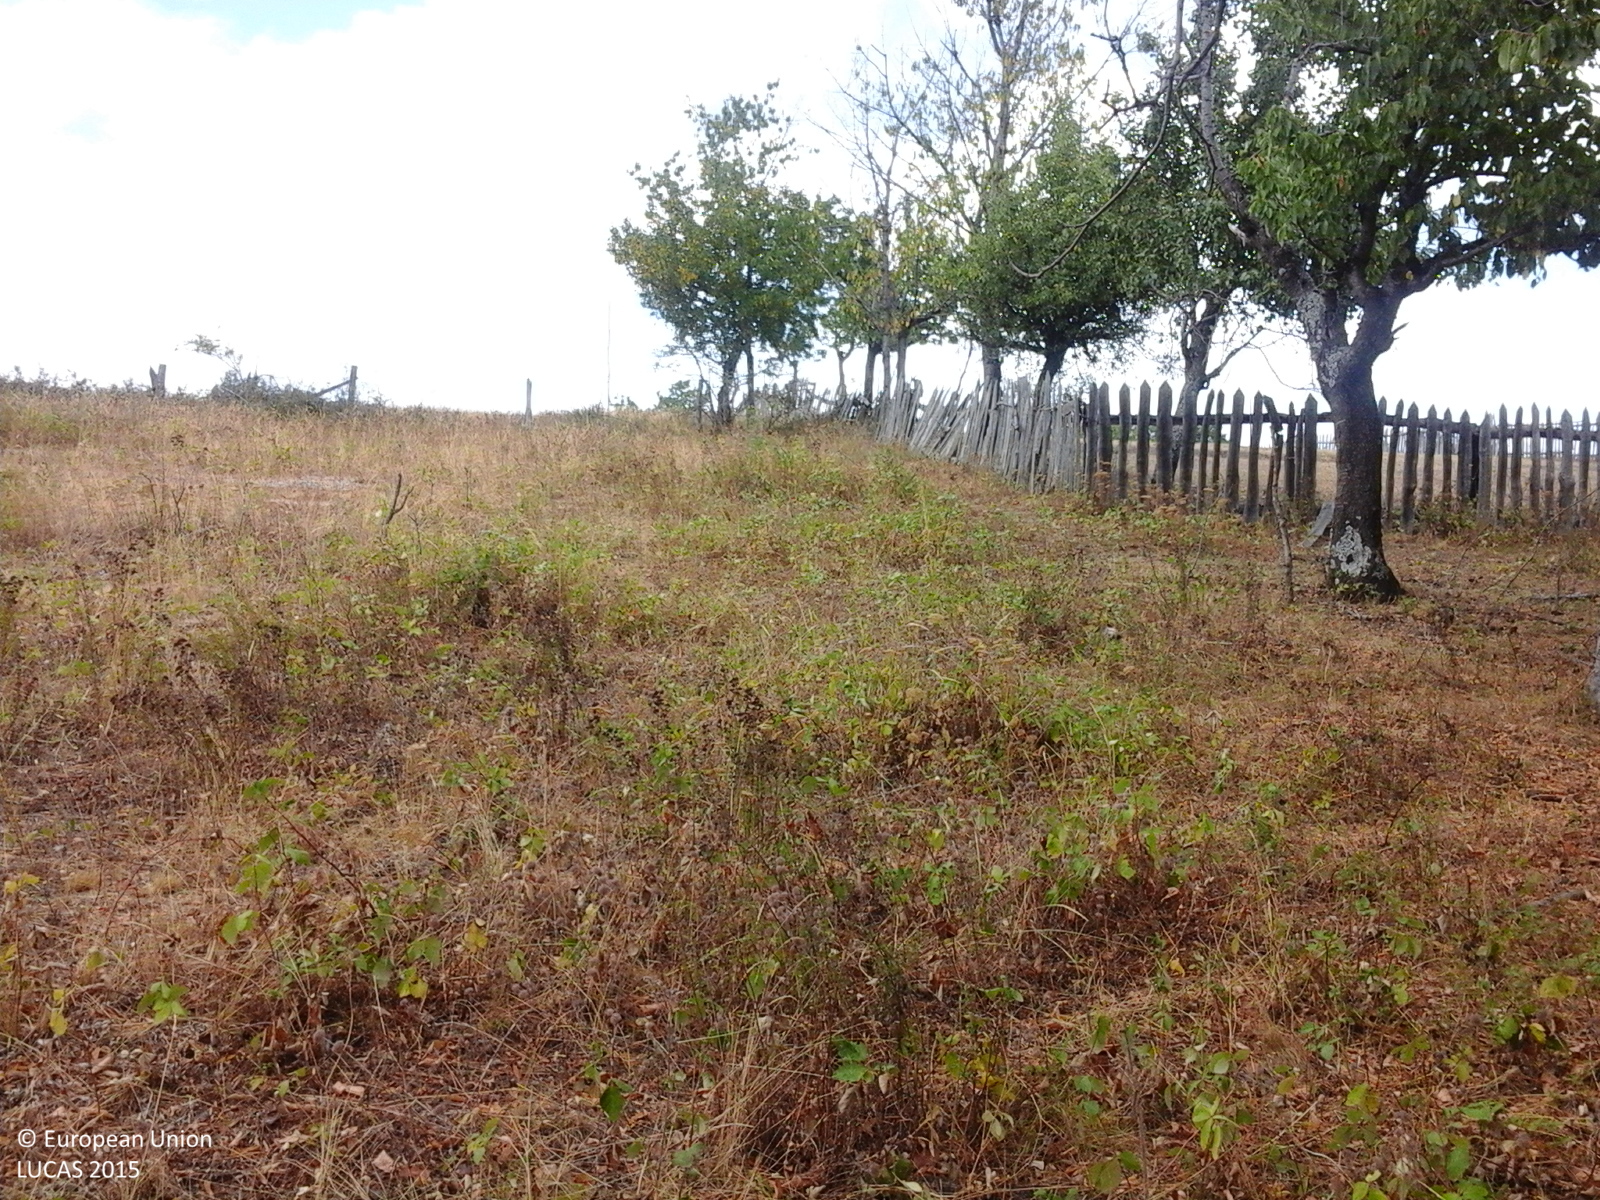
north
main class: Woodland
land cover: Broadleaved woodland
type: acidophilous oak and oak-birch forest
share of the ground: > 75 %
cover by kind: broadleaved forest trees 100 %
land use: Forestry
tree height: > 5 m
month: August
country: RO
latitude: 44.7866
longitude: 22.5667
